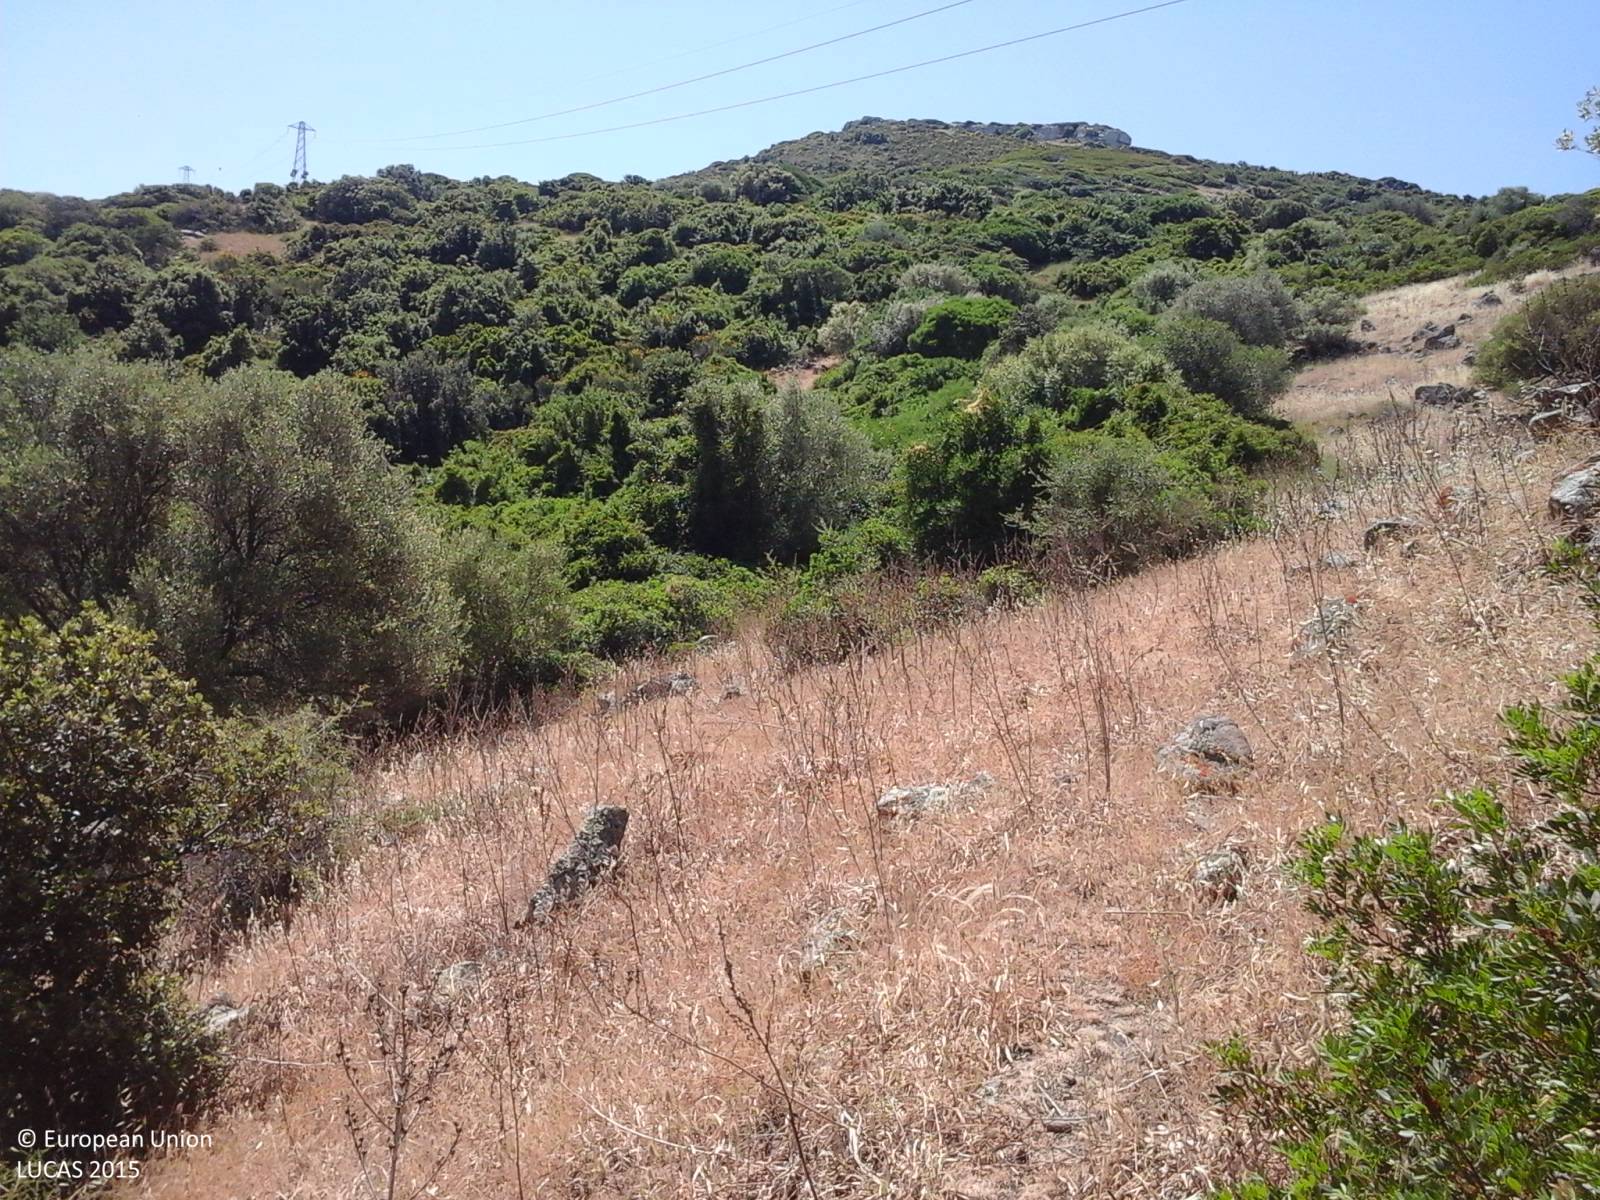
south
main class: Shrubland
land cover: Shrubland with sparse tree cover
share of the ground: > 75 %
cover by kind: shrubs 50 %, herbaceous plants 40 %, broadleaved forest trees 5 %
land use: Semi-natural and natural areas not in use
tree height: < 5 m
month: May
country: IT
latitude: 40.8013
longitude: 8.6670
